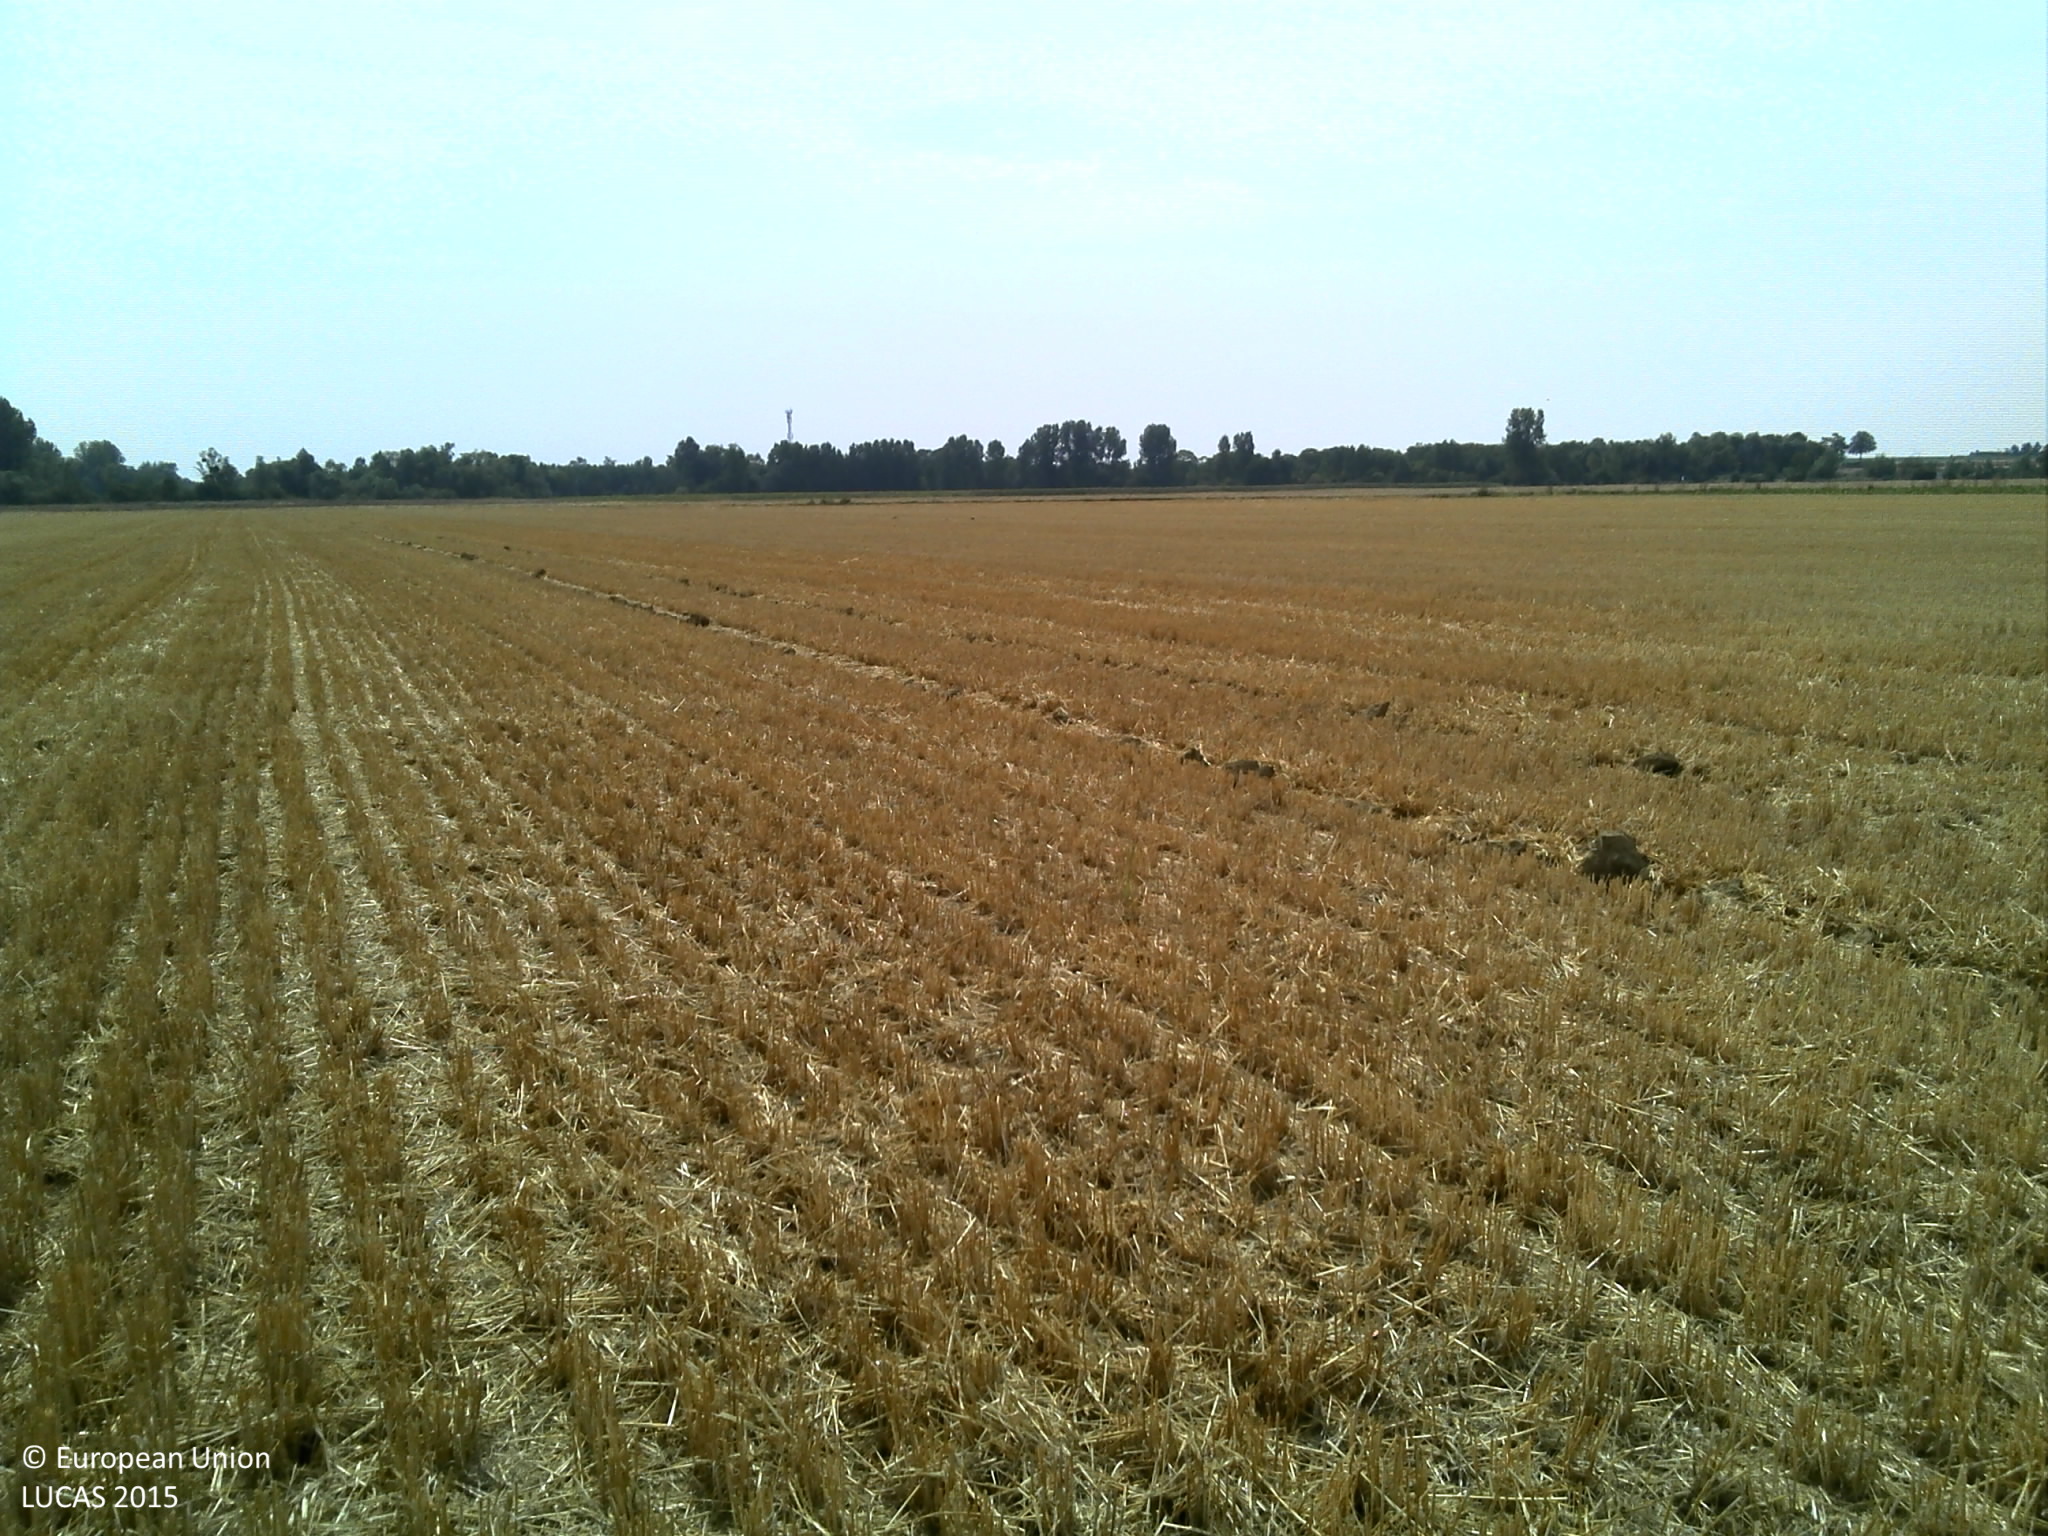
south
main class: Cropland
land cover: Barley
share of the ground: > 75 %
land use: Agriculture (excluding fallow land and kitchen gardens)
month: August
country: FR
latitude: 49.0095
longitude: 4.2128
